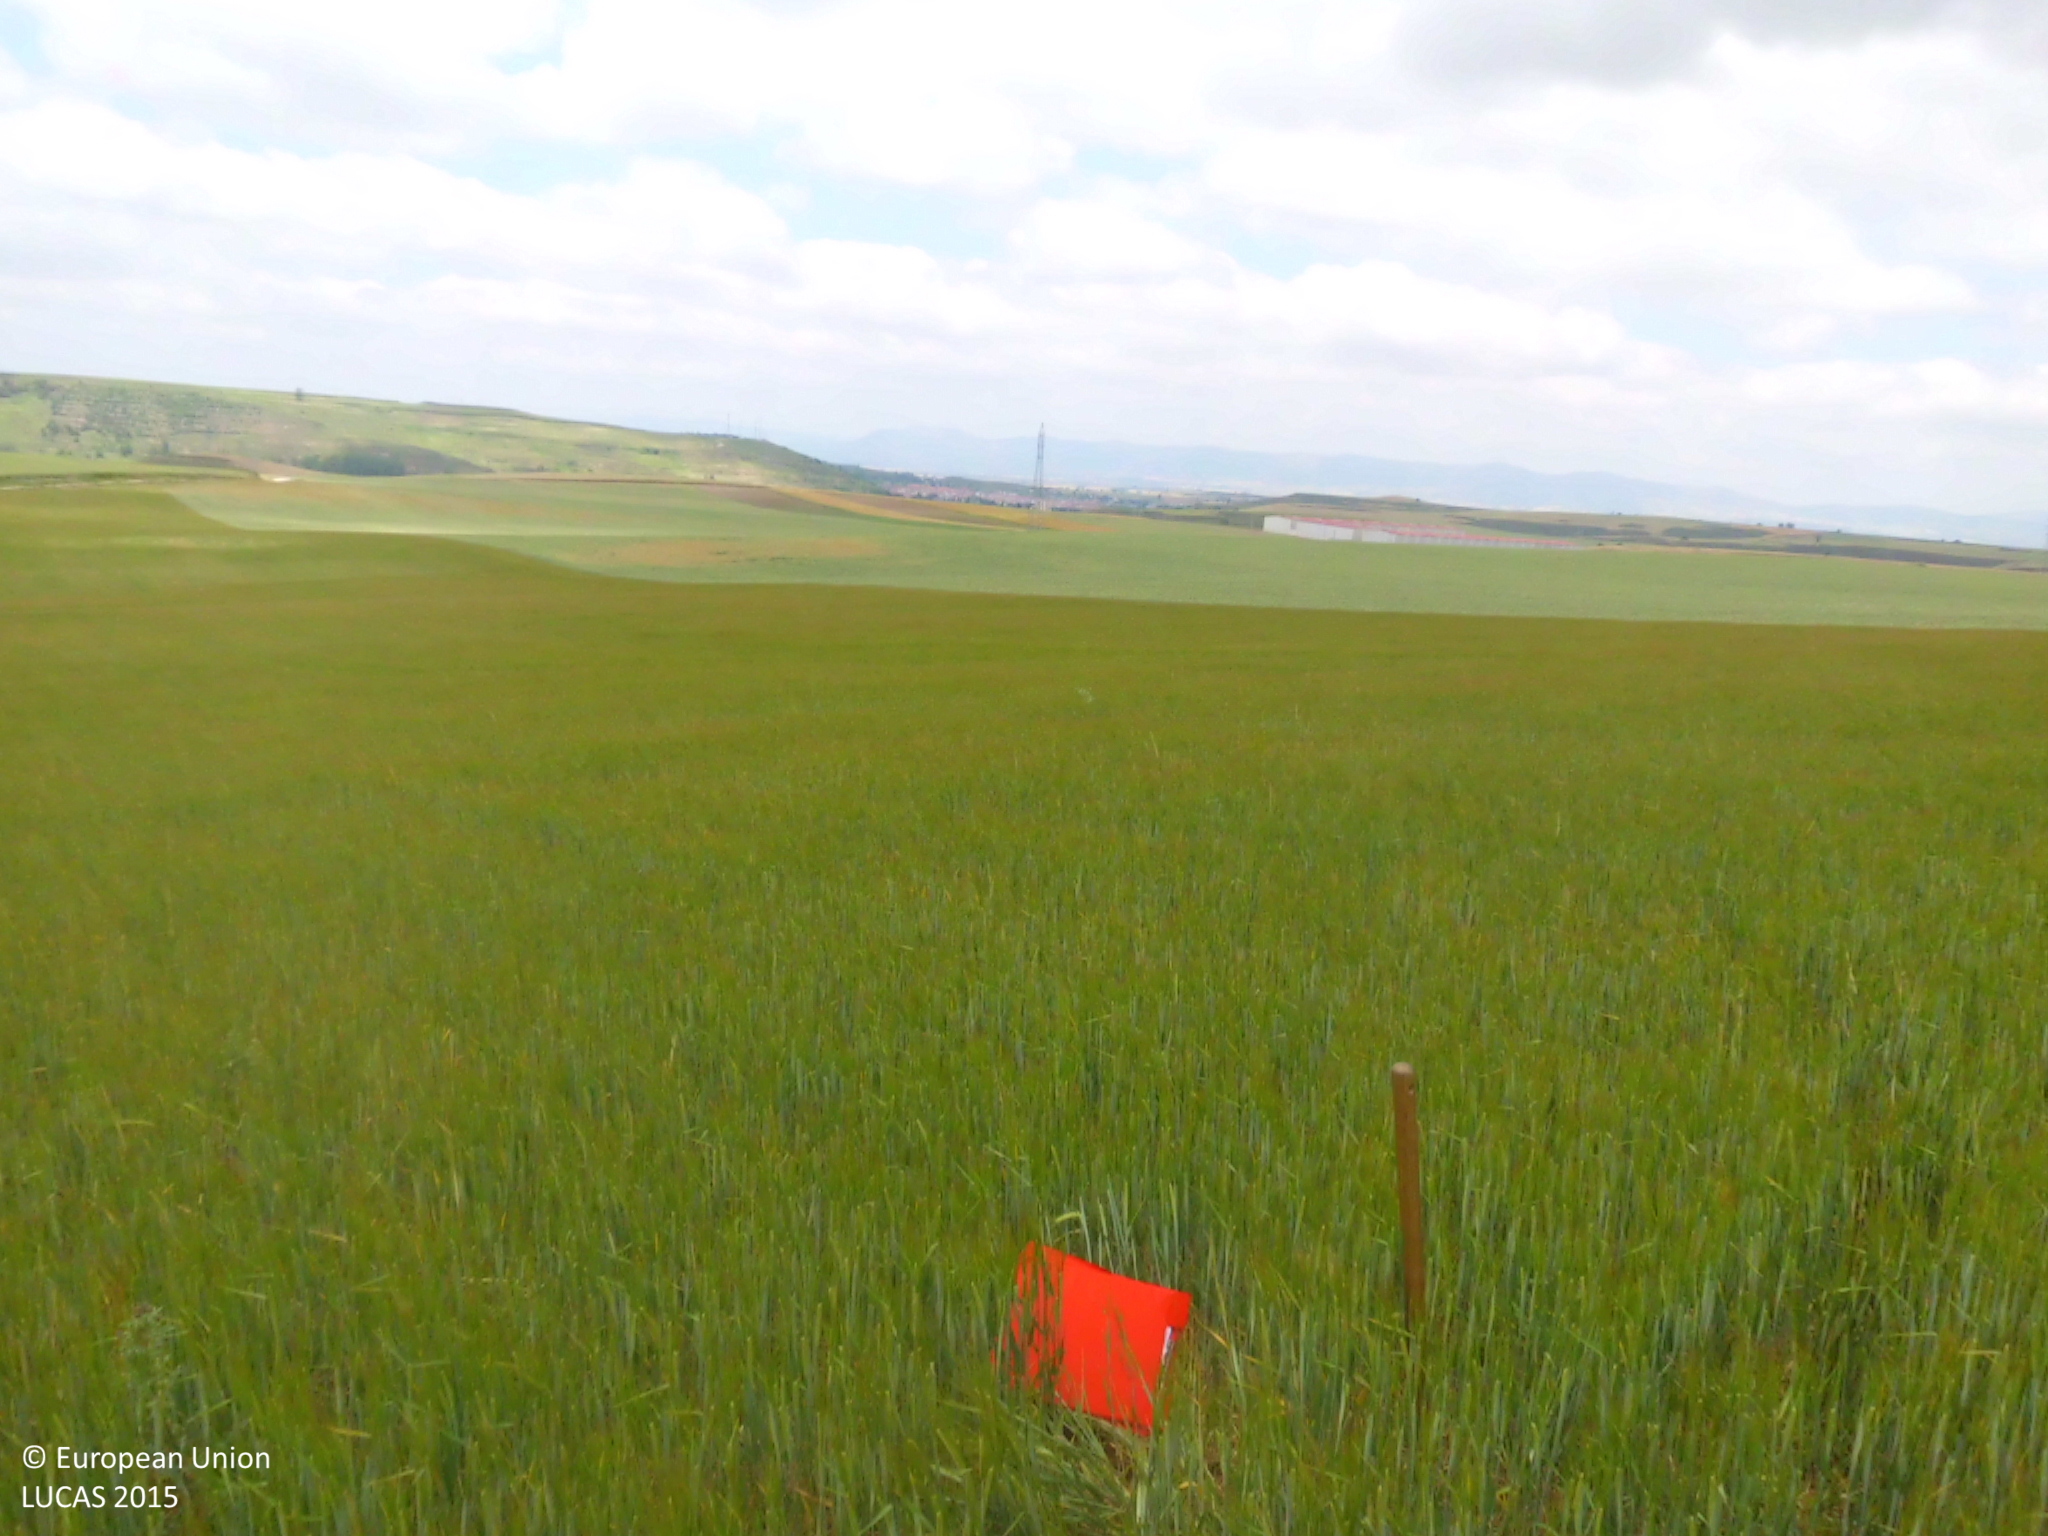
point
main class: Cropland
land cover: Barley
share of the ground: > 75 %
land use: Agriculture (excluding fallow land and kitchen gardens)
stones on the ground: < 10 %
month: June
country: ES
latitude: 42.5203
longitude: -3.3125
